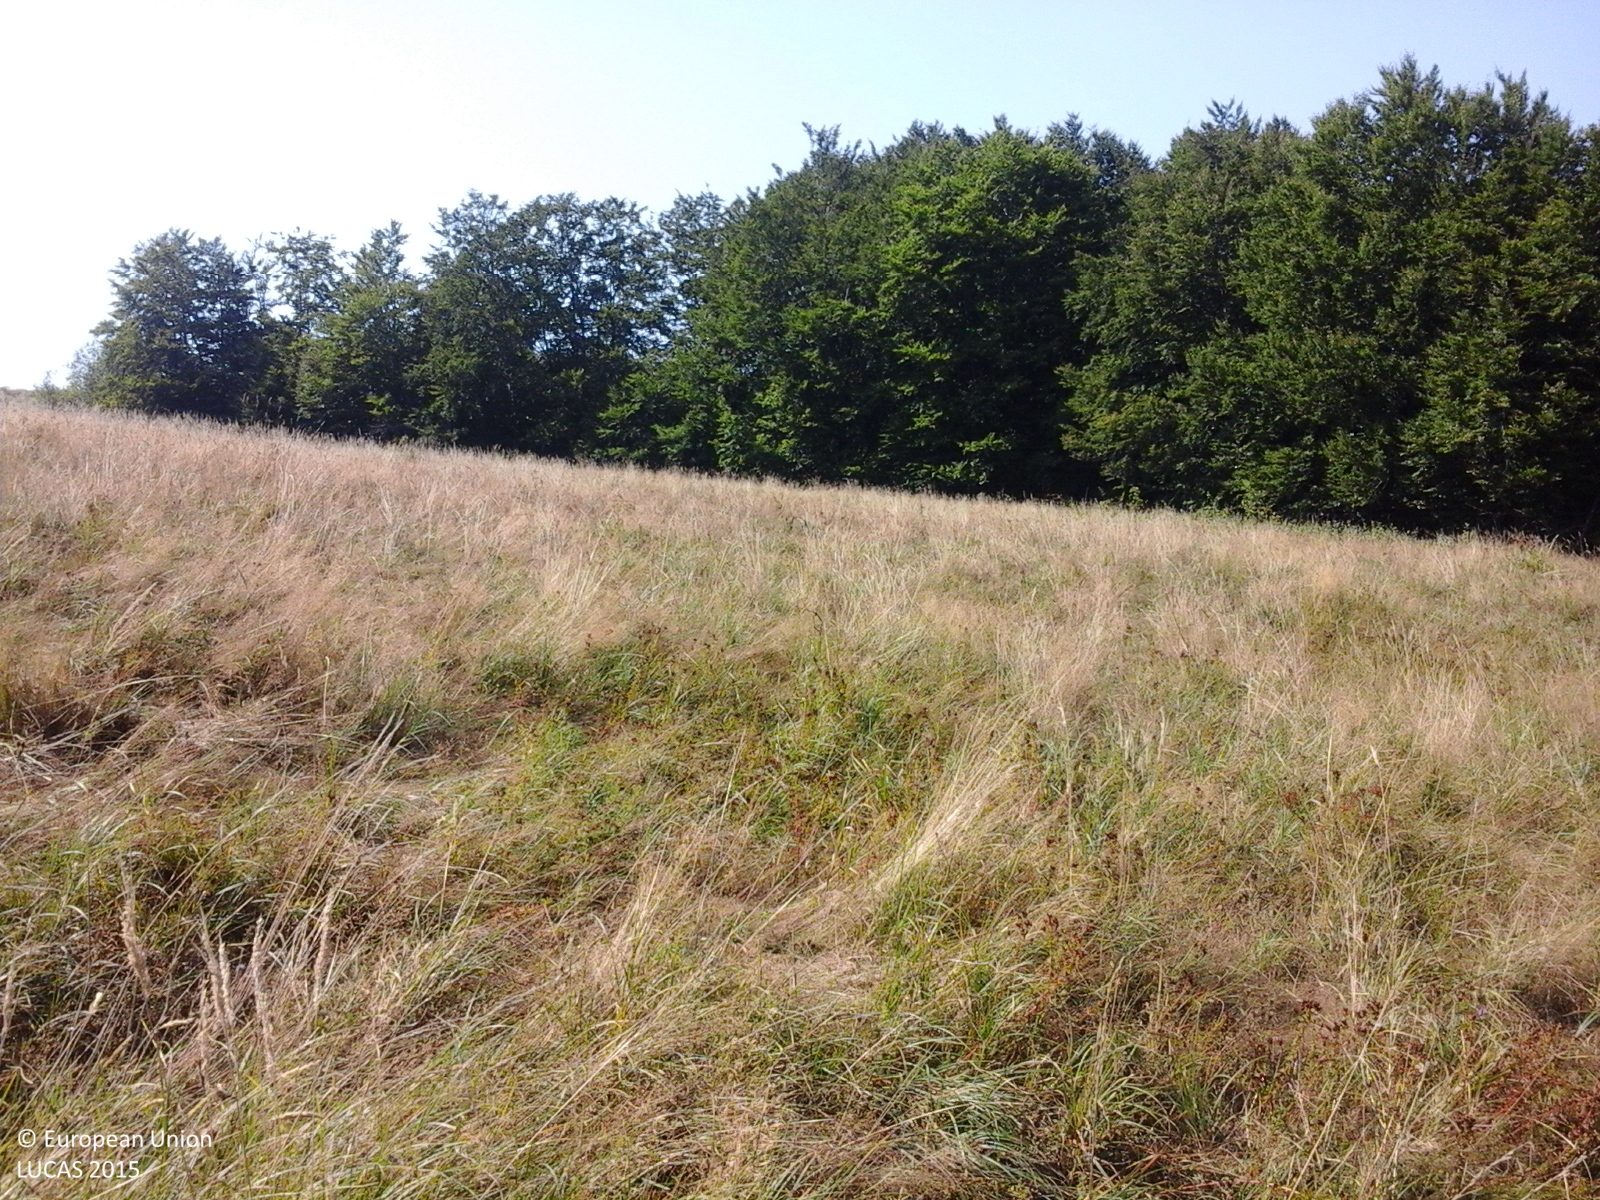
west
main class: Grassland
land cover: Grassland without tree/shrub cover
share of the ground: > 75 %
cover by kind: herbaceous plants 100 %
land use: Agriculture (excluding fallow land and kitchen gardens)
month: August
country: RO
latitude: 45.8594
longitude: 22.7378
